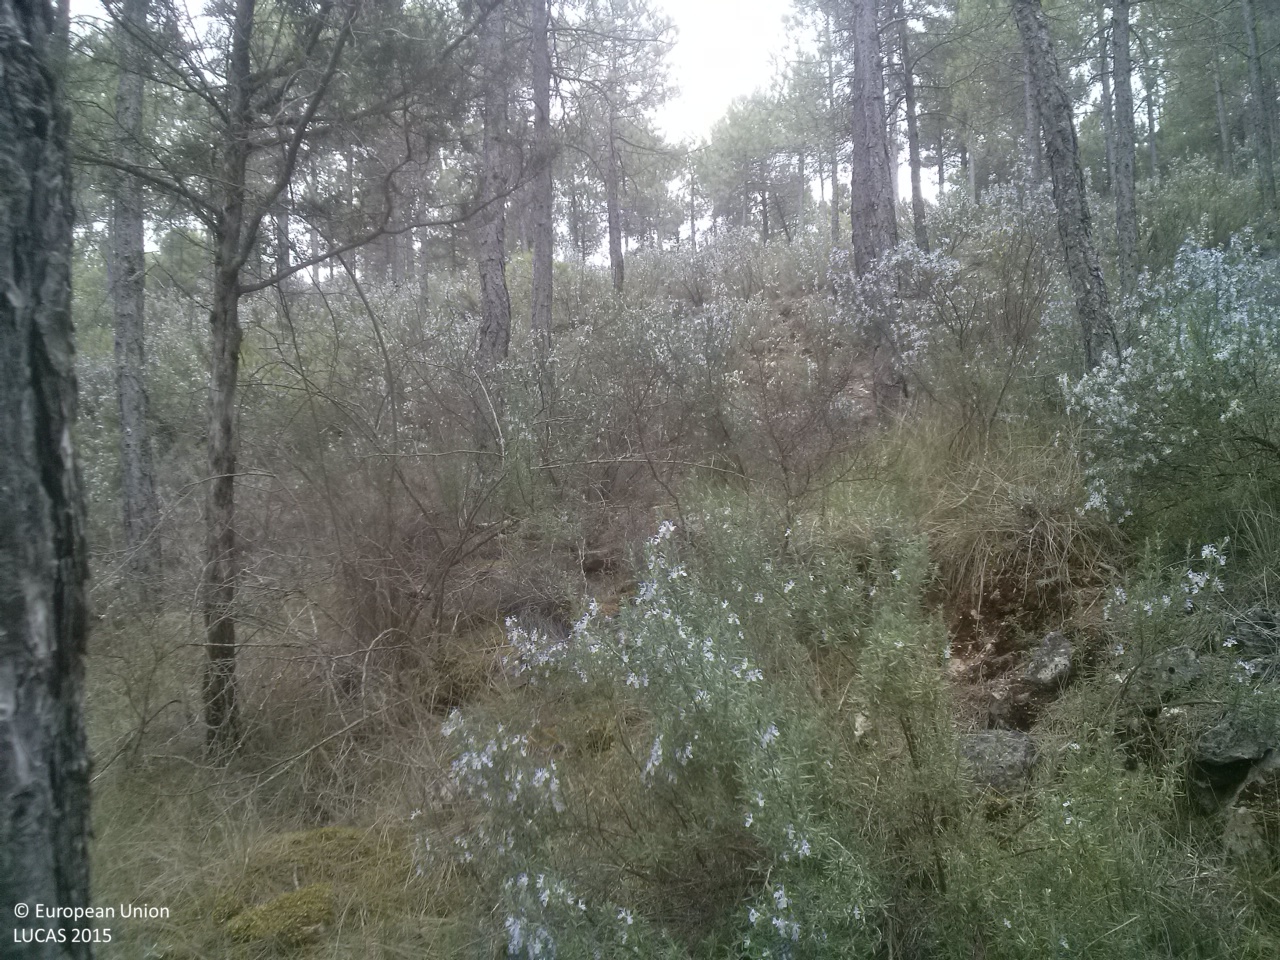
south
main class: Woodland
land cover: Pine dominated coniferous woodland
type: coniferous forest of the mediterranean region
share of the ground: 50 - 75 %
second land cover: Shrubland without tree cover
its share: 50 - 75 %
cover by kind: coniferous forest trees 75 %, herbaceous plants 20 %, shrubs 5 %
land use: Forestry
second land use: Agriculture (excluding fallow land and kitchen gardens)
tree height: > 5 m
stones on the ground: < 10 %
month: April
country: ES
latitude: 39.9969
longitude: -1.9013
